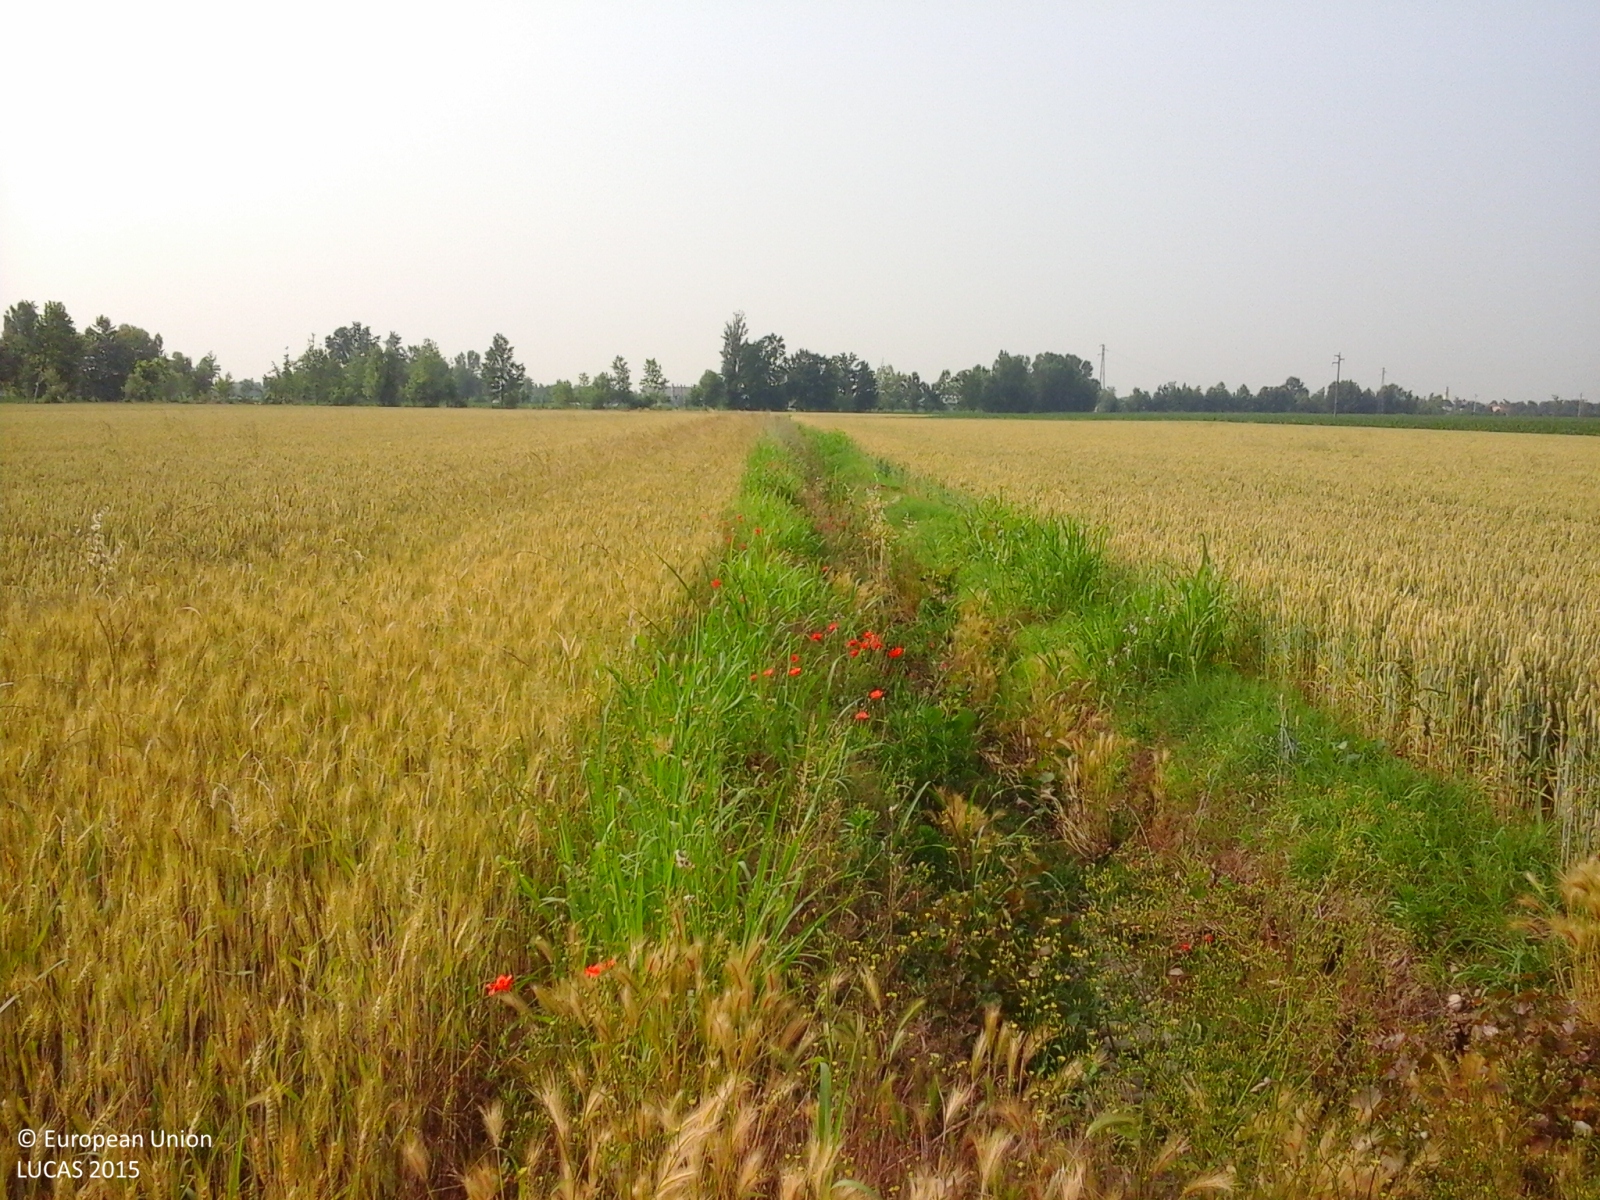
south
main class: Cropland
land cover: Common wheat
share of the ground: > 75 %
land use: Agriculture (excluding fallow land and kitchen gardens)
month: June
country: IT
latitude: 45.4503
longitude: 10.0638
